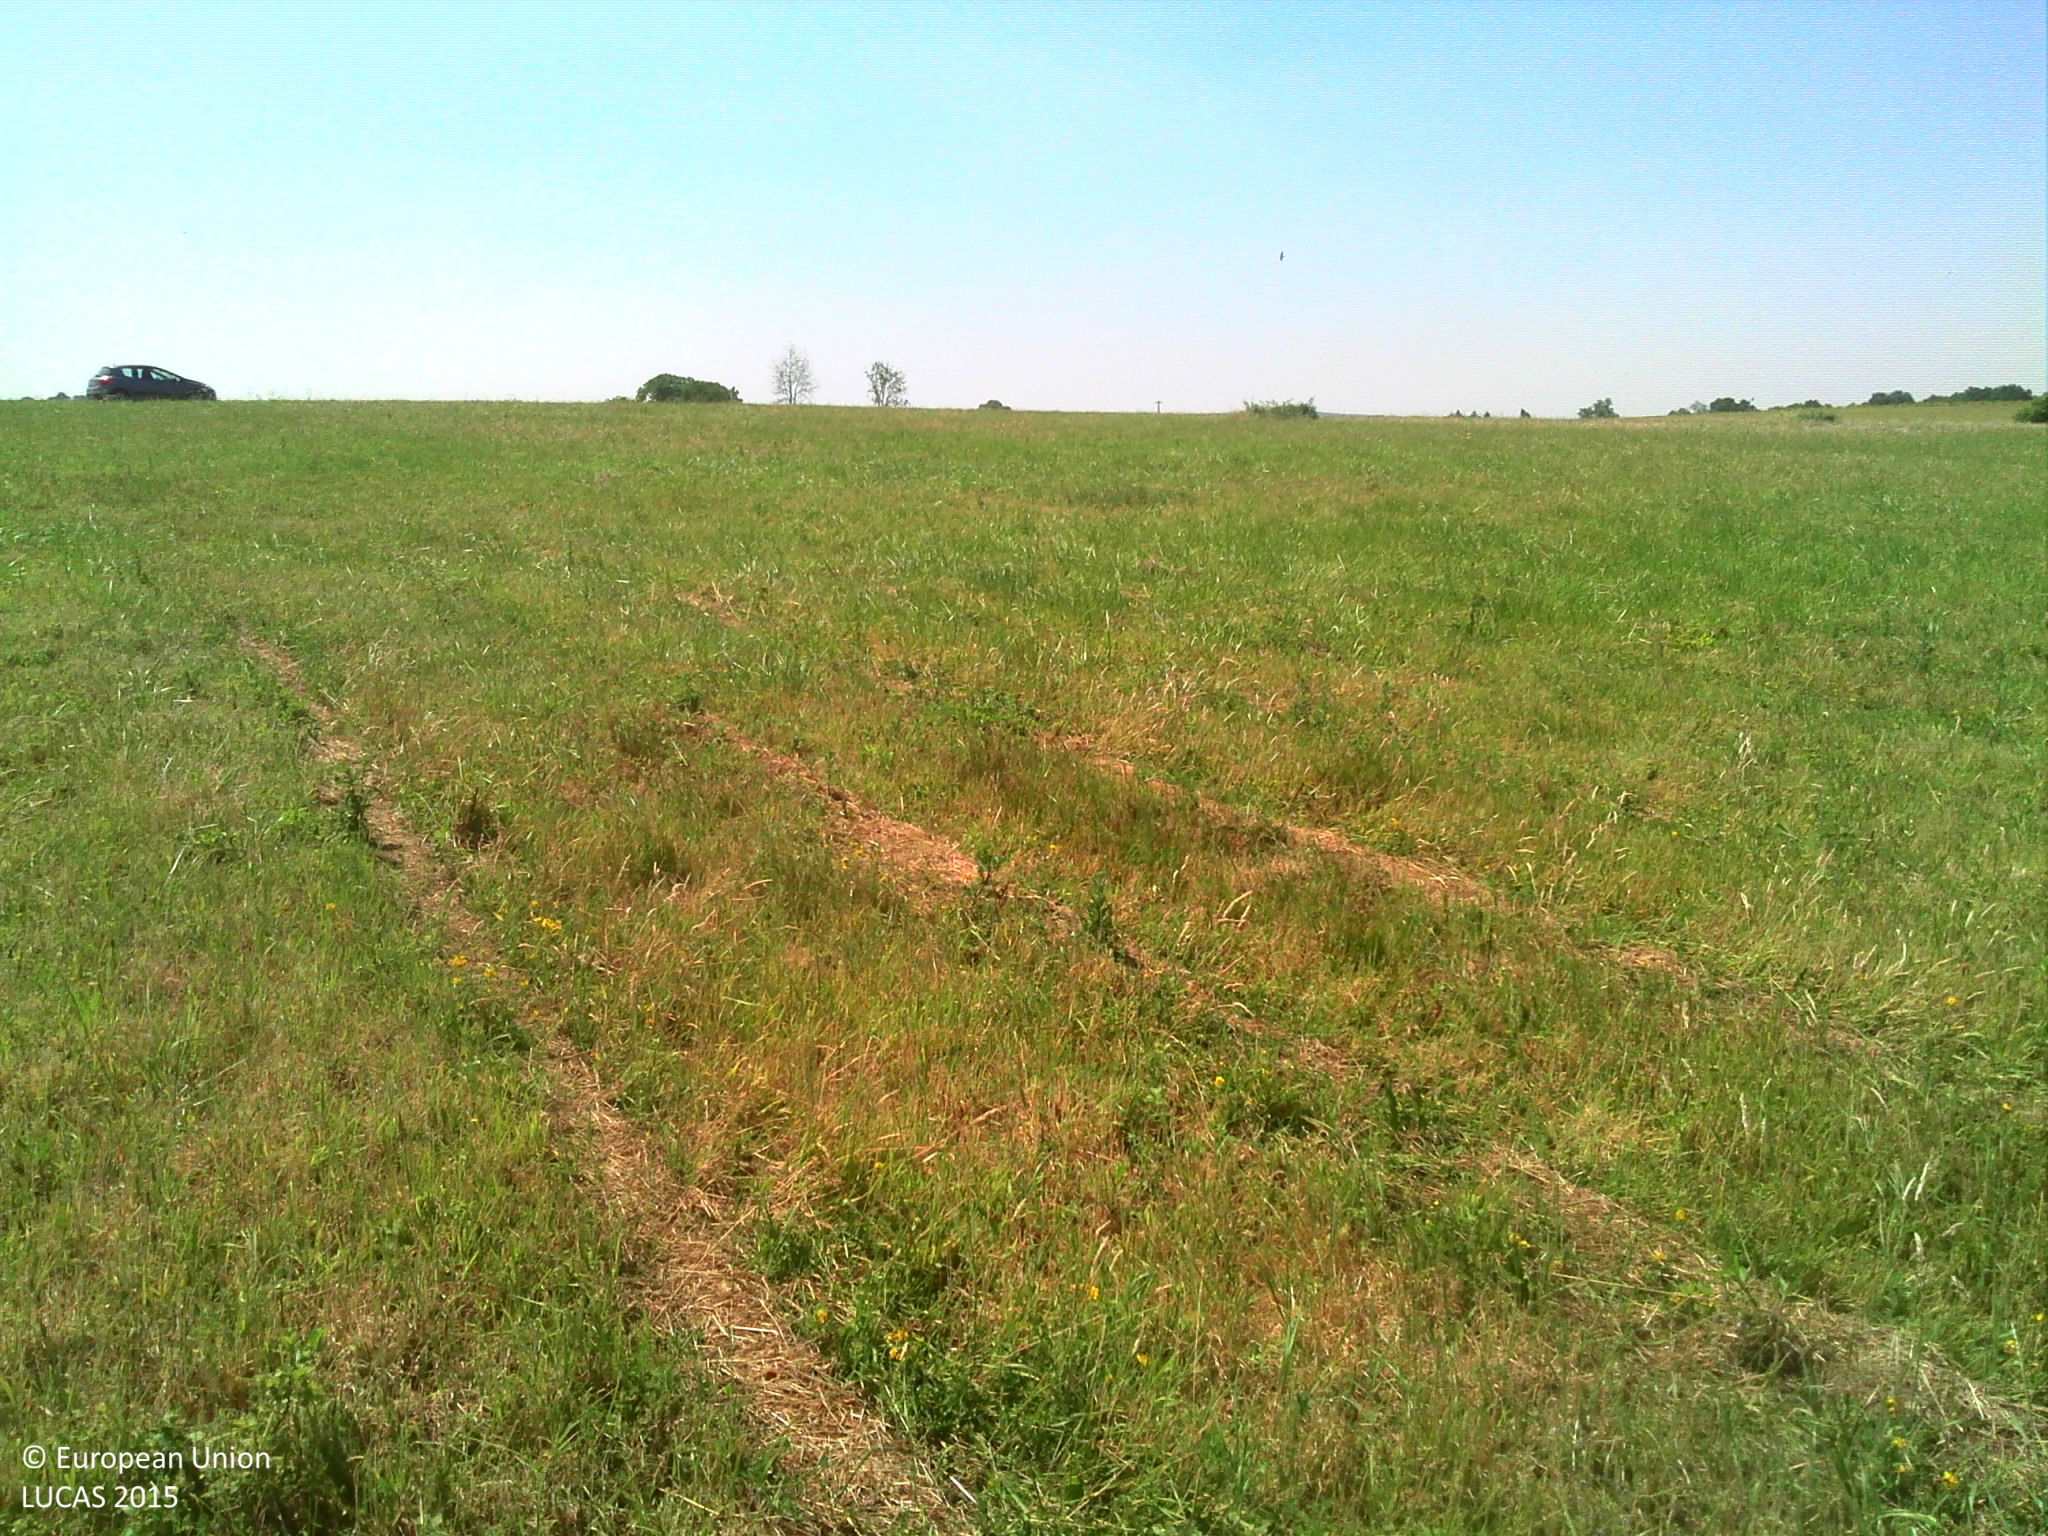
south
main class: Grassland
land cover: Grassland without tree/shrub cover
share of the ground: > 75 %
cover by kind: herbaceous plants 100 %
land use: Agriculture (excluding fallow land and kitchen gardens)
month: June
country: FR
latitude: 47.3271
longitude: 2.9153
